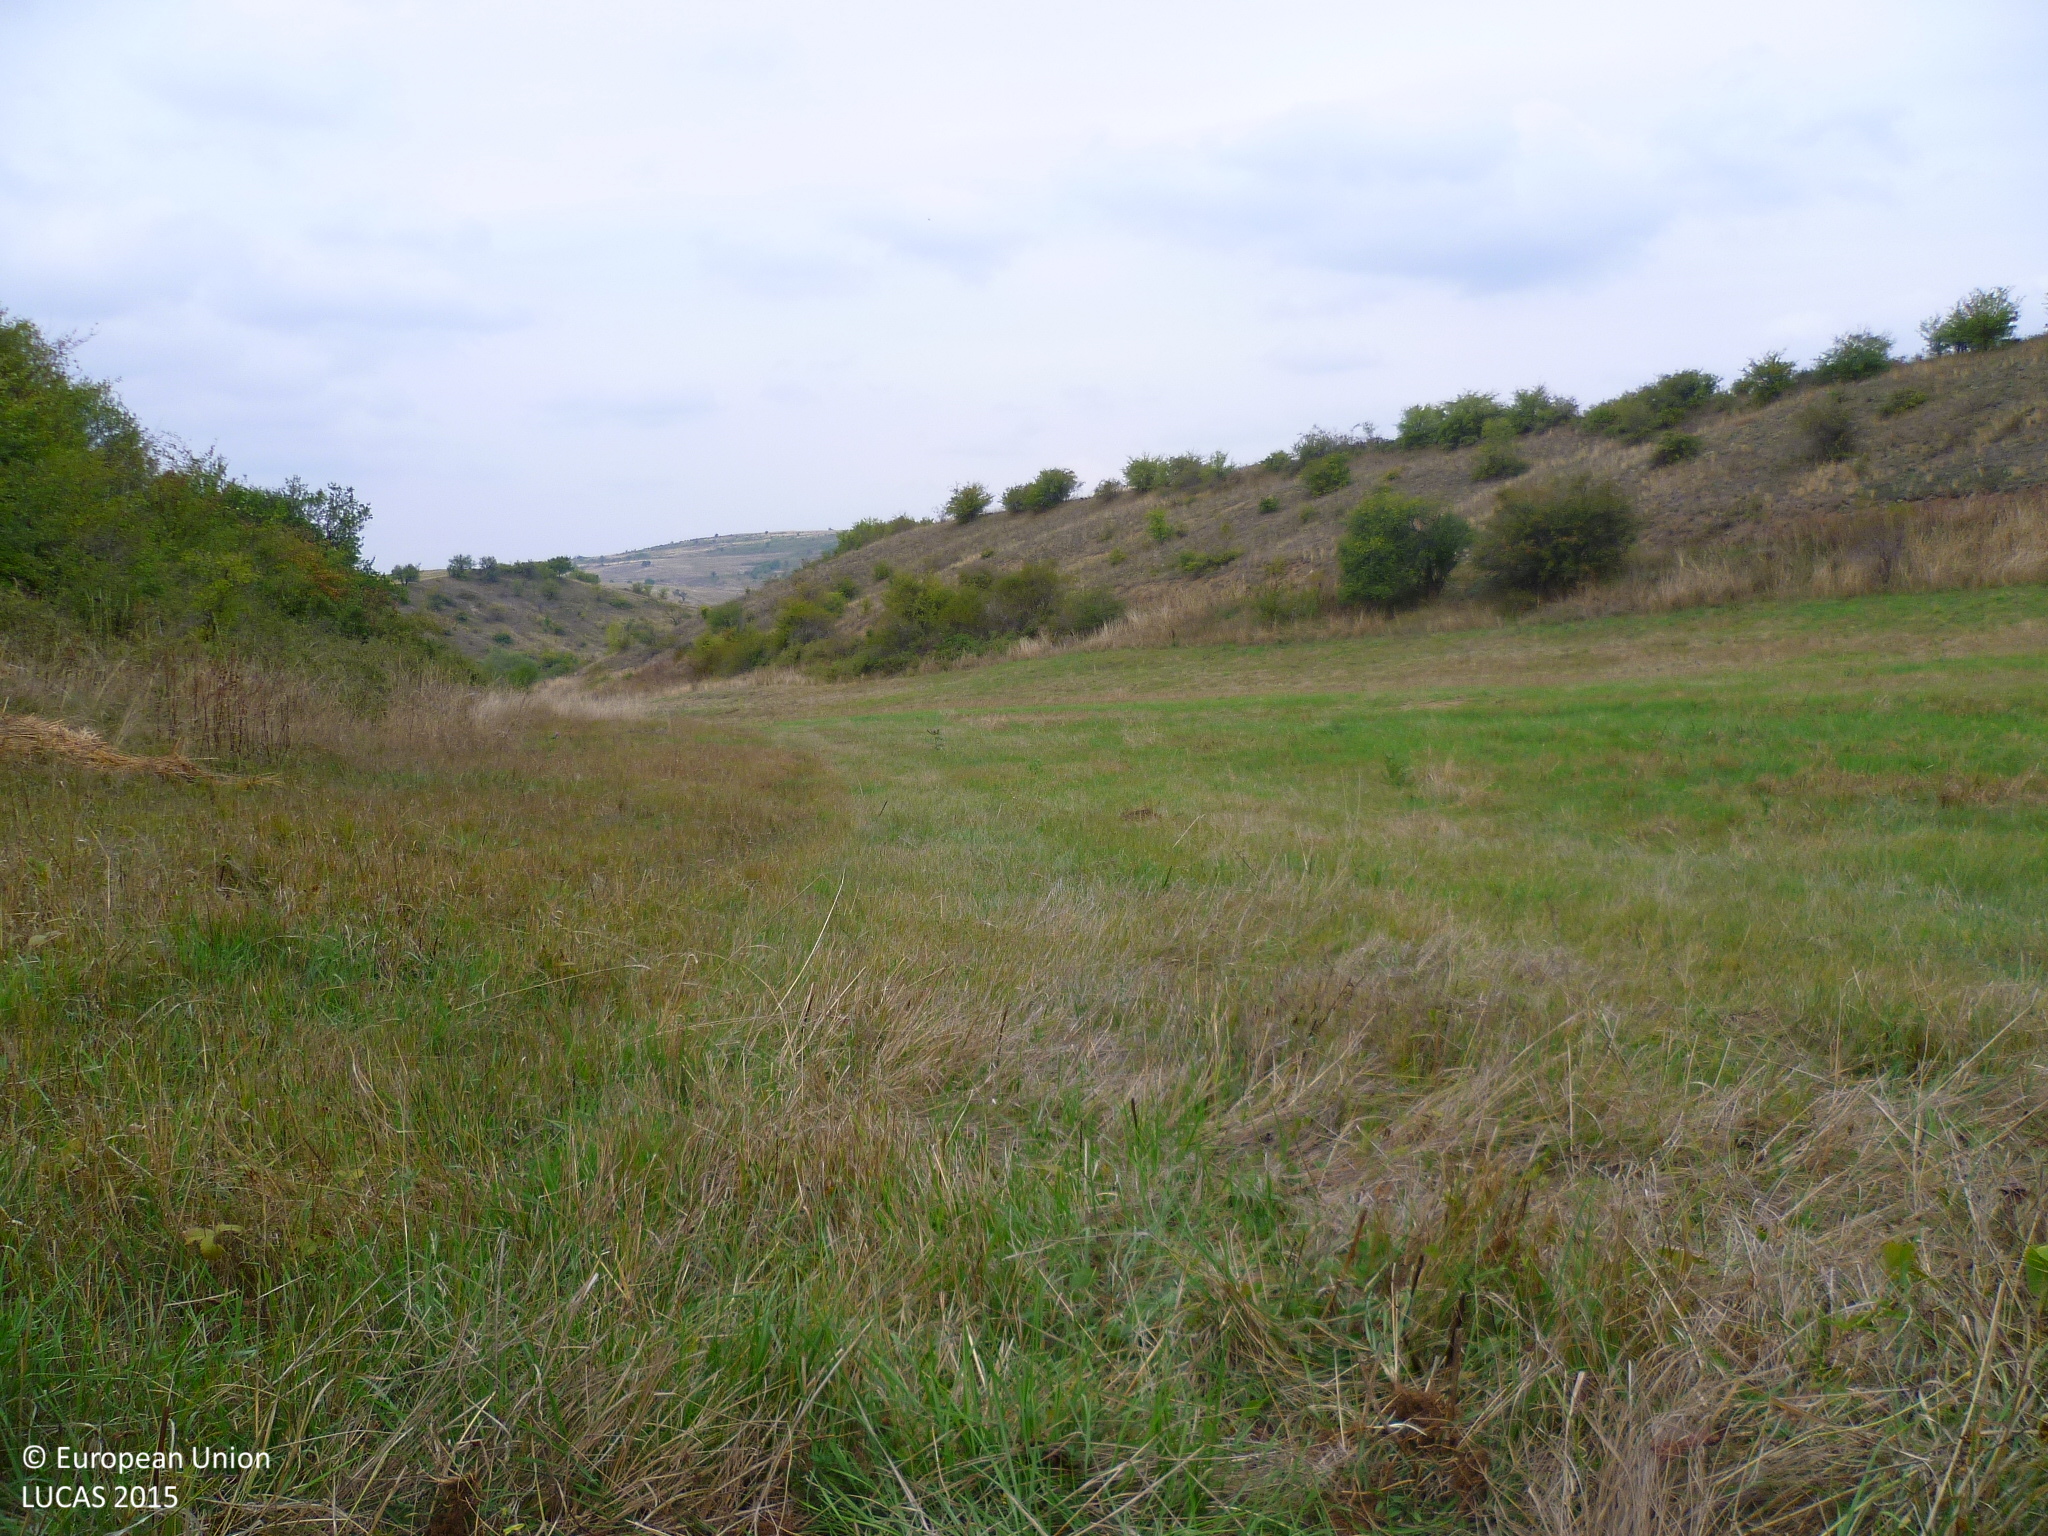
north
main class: Grassland
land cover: Grassland without tree/shrub cover
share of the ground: > 75 %
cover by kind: herbaceous plants 100 %
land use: Agriculture (excluding fallow land and kitchen gardens)
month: September
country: BG
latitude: 42.7658
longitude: 22.9715
